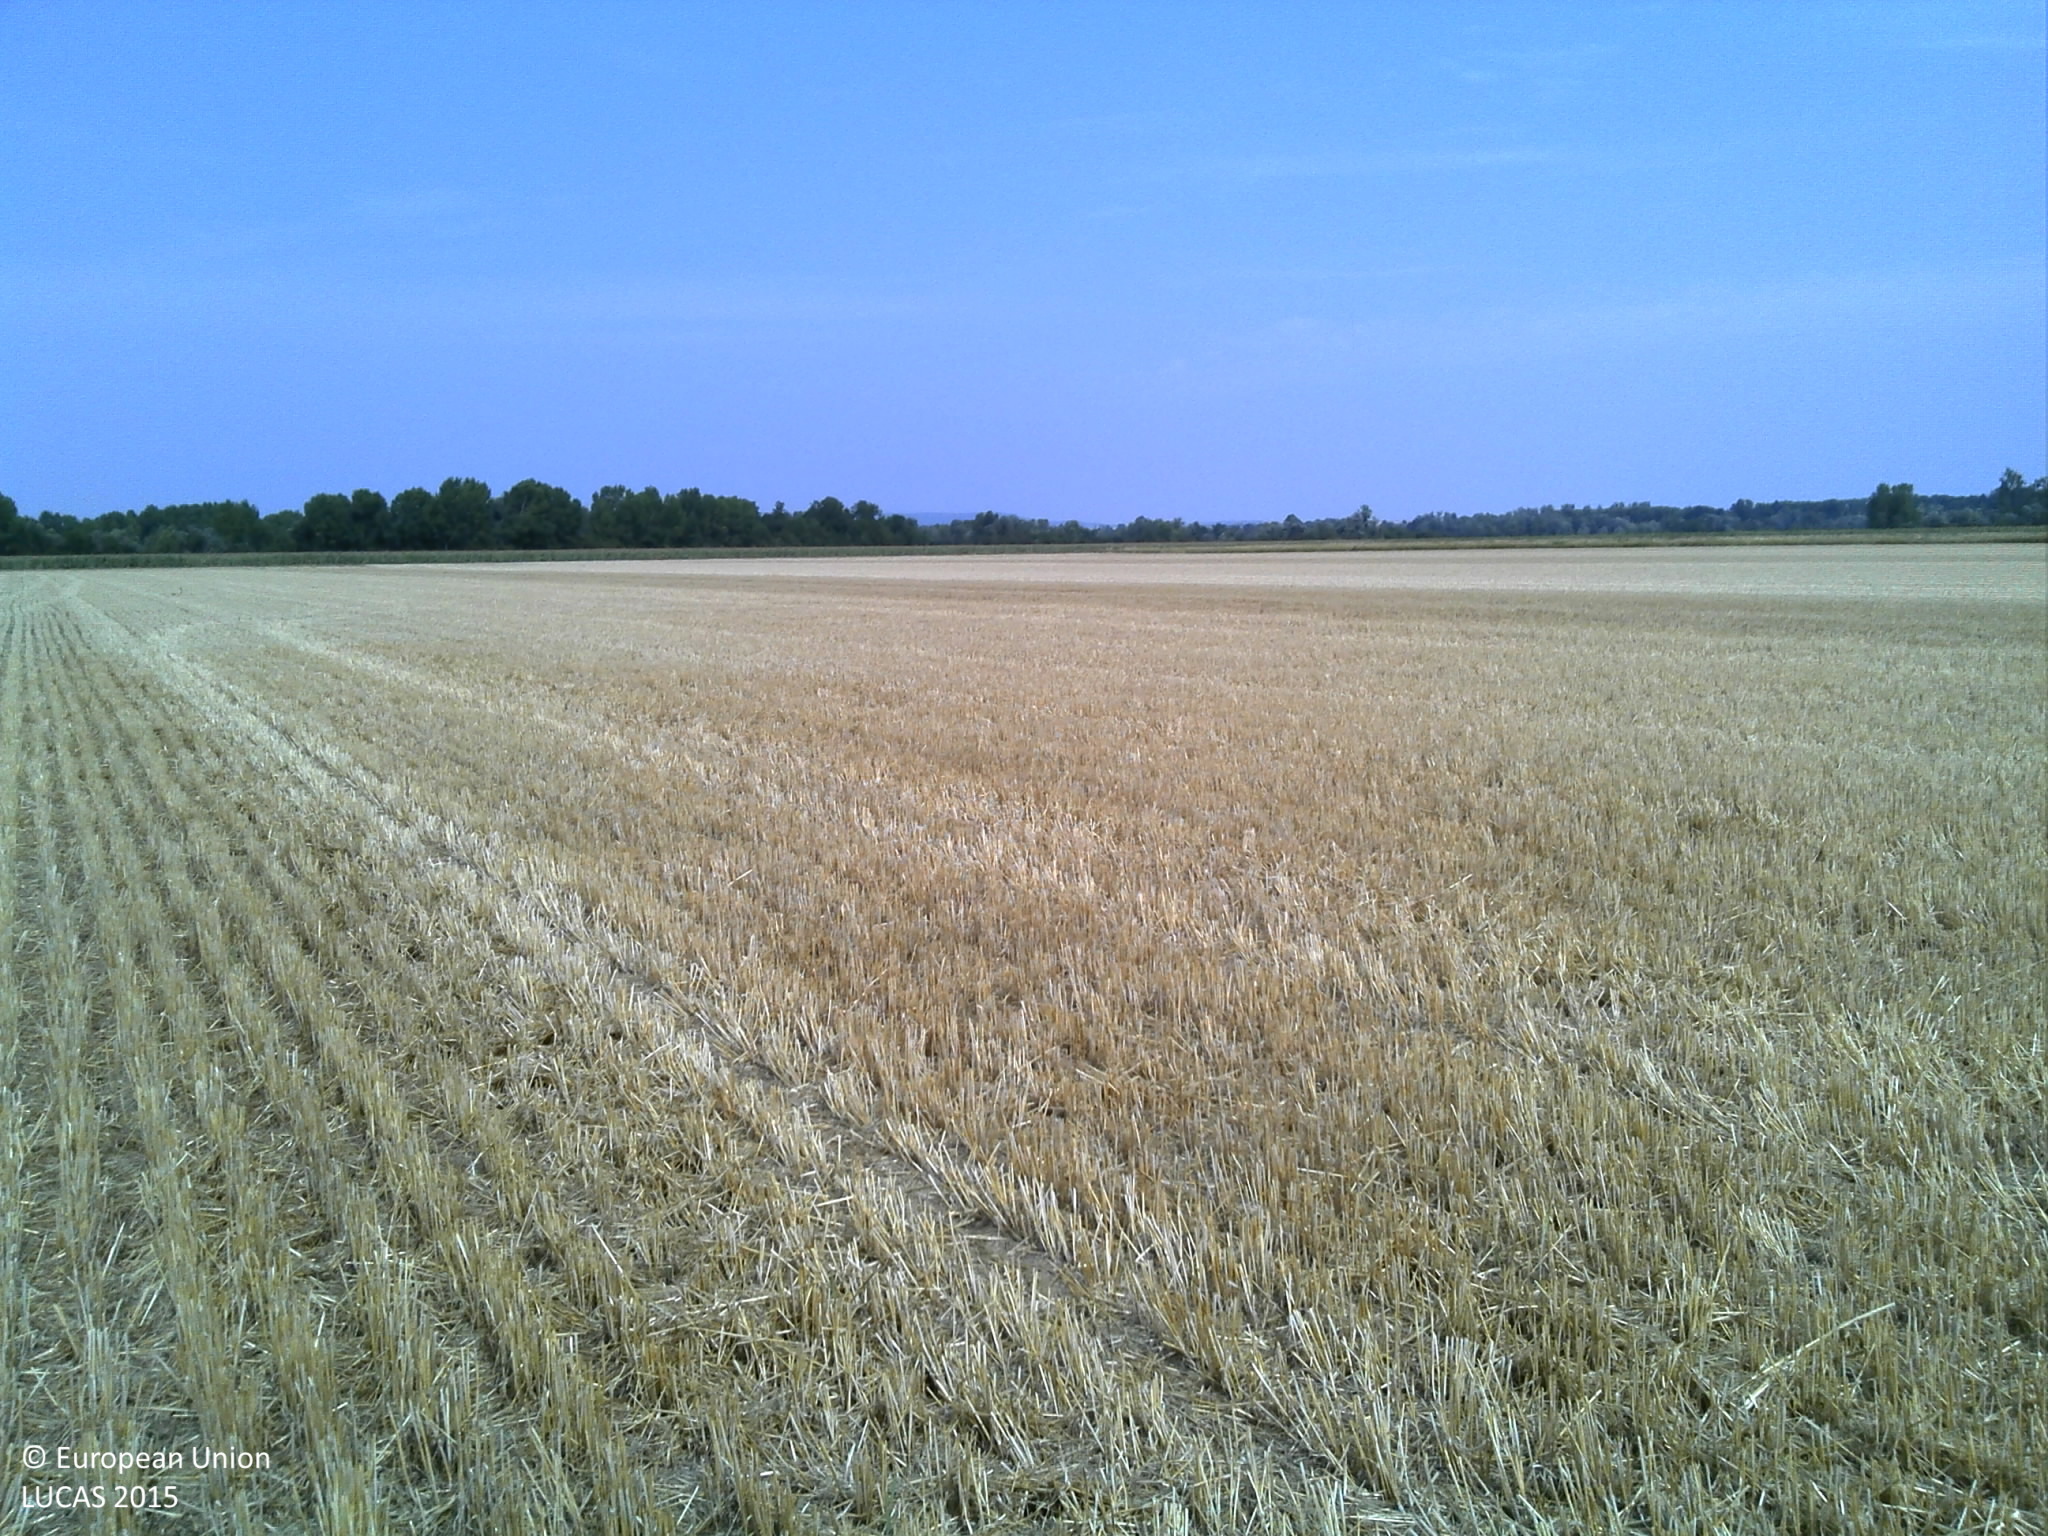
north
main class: Cropland
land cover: Barley
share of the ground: > 75 %
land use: Agriculture (excluding fallow land and kitchen gardens)
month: August
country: FR
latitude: 49.0095
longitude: 4.2128
